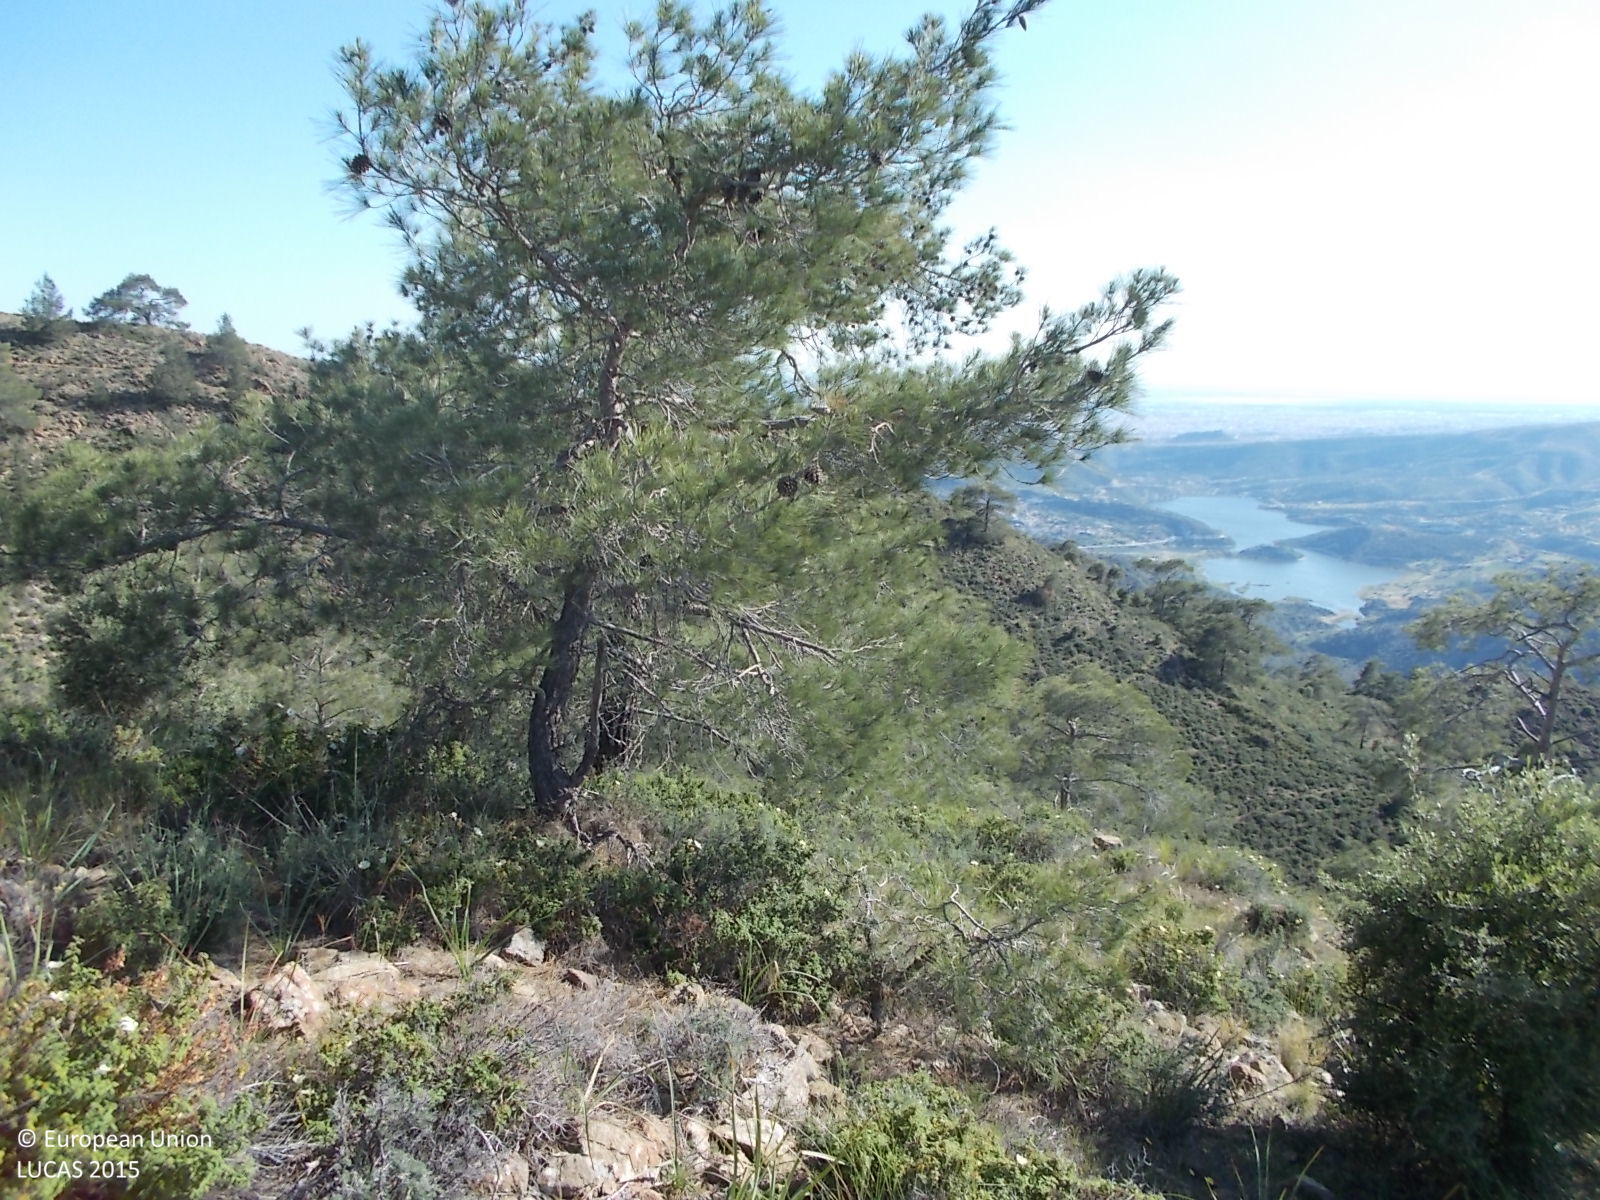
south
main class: Woodland
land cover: Pine dominated coniferous woodland
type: coniferous forest of the mediterranean region
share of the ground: 50 - 75 %
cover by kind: coniferous forest trees 50 %, shrubs 20 %, unconsolidated bare surface 20 %, herbaceous plants 10 %
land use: Semi-natural and natural areas not in use
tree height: > 5 m
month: April
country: CY
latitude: 34.7847
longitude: 33.1092
